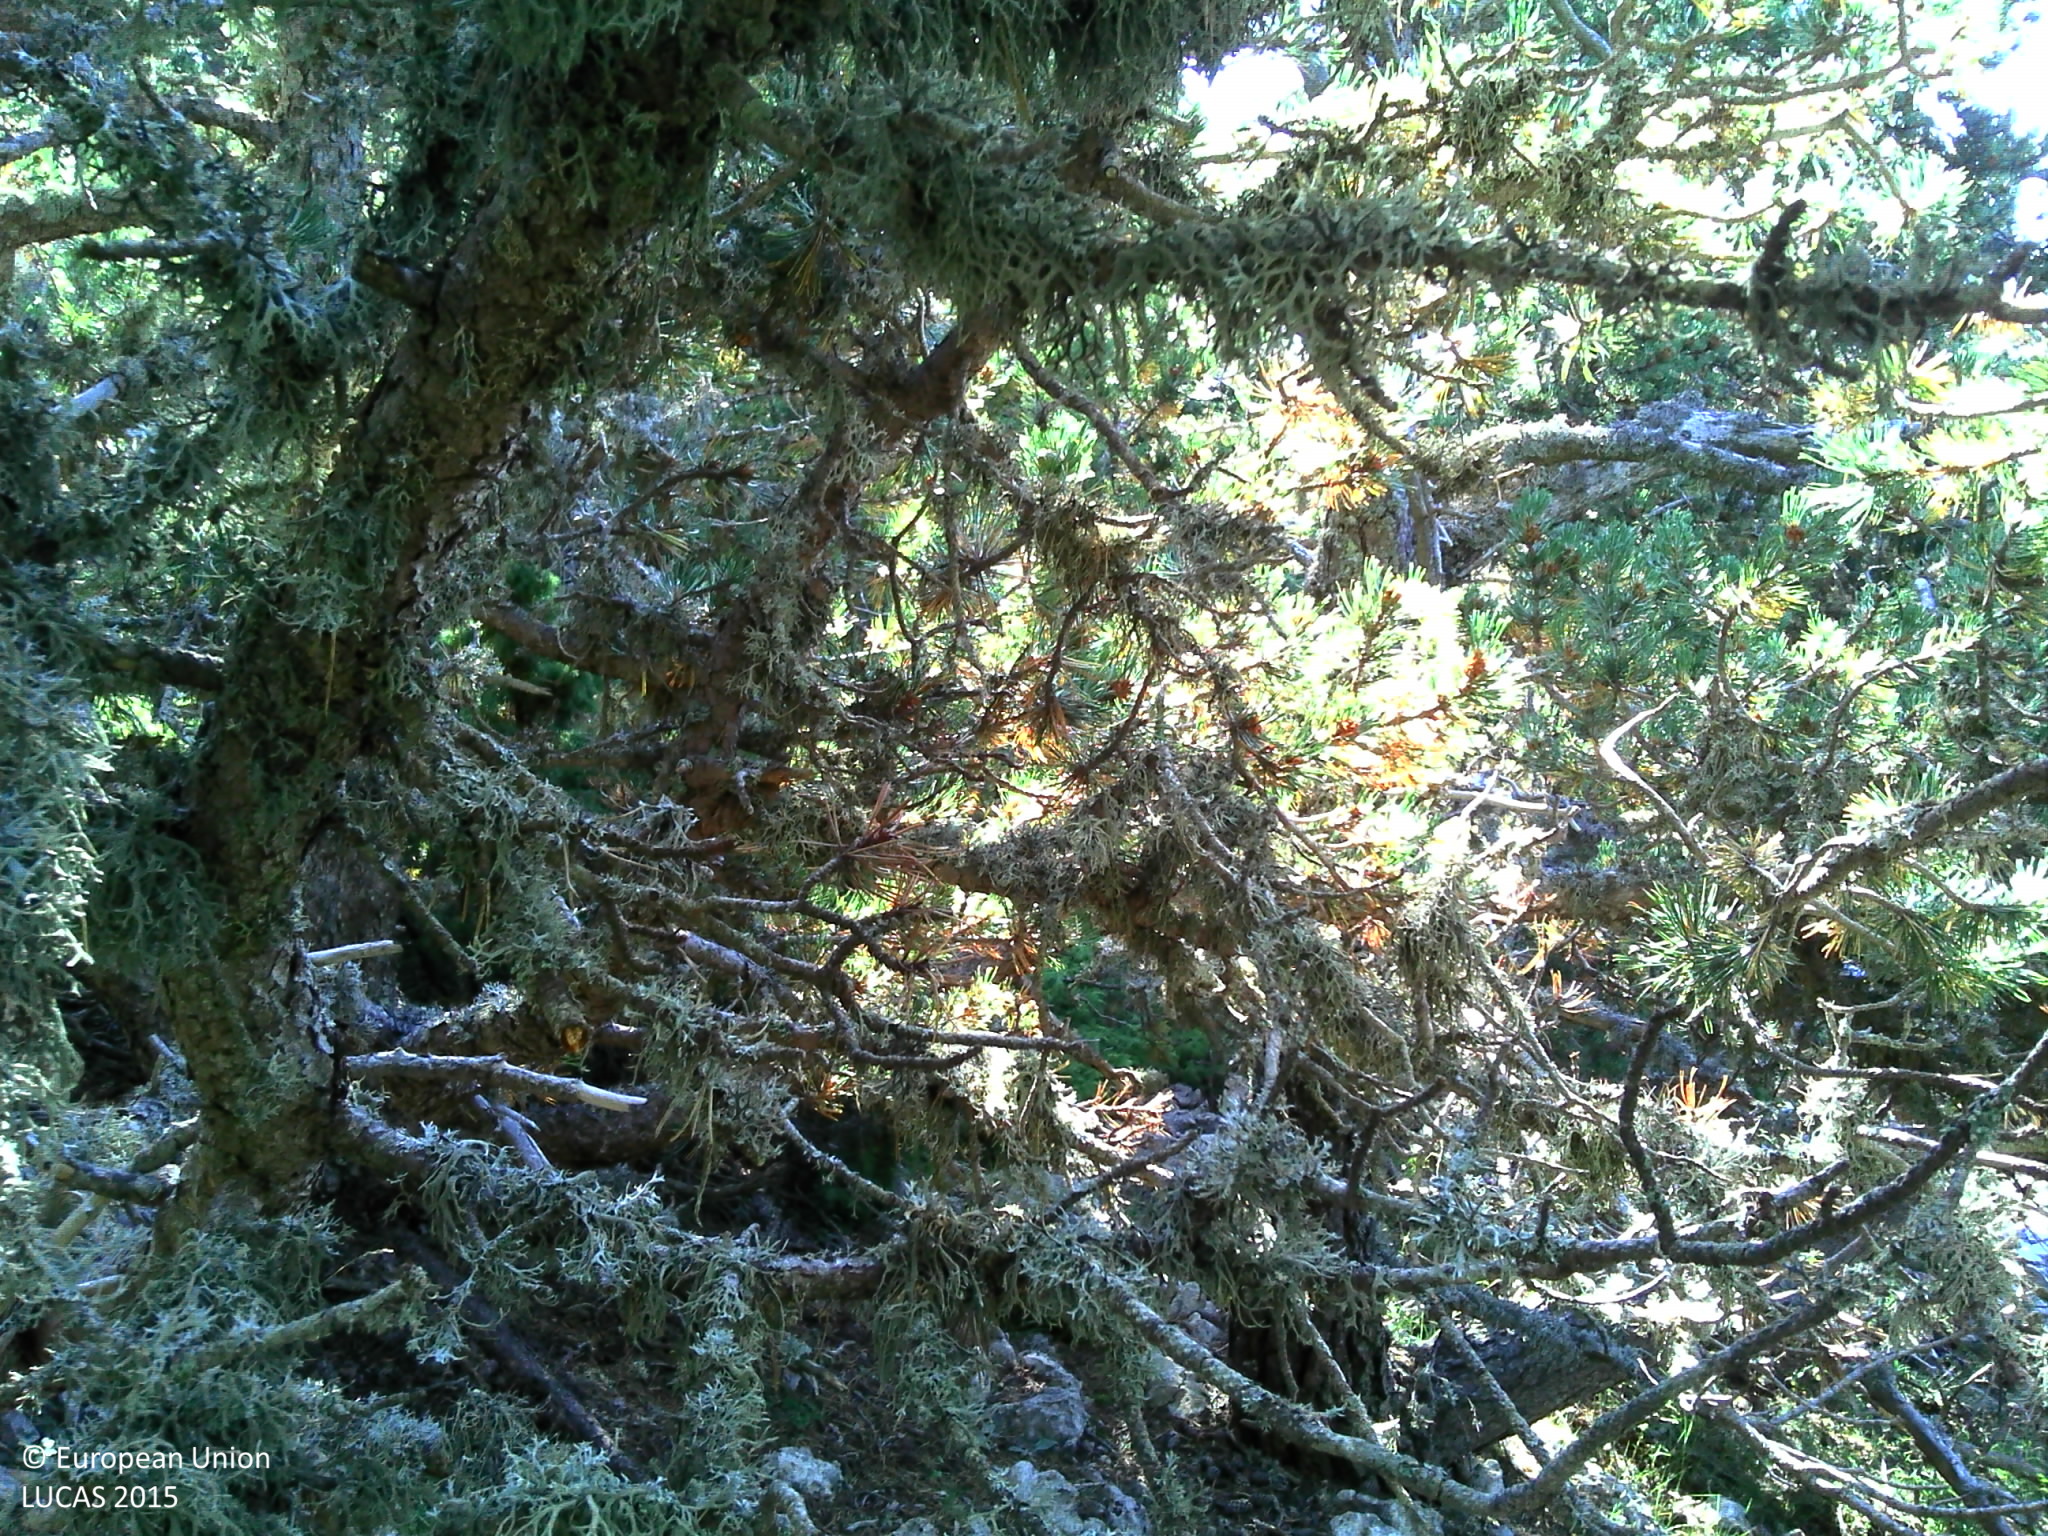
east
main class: Woodland
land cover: Other coniferous woodland
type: coniferous forest of the mediterranean region
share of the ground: > 75 %
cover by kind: coniferous forest trees 45 %, lichens and mosses 15 %, unconsolidated bare surface 15 %, shrubs 10 %, herbaceous plants 10 %, broadleaved forest trees 5 %
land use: Semi-natural and natural areas not in use
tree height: > 5 m
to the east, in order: Other coniferous woodland; Rocks and stones; Other coniferous woodland
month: July
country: FR
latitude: 44.1692
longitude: 5.2430
